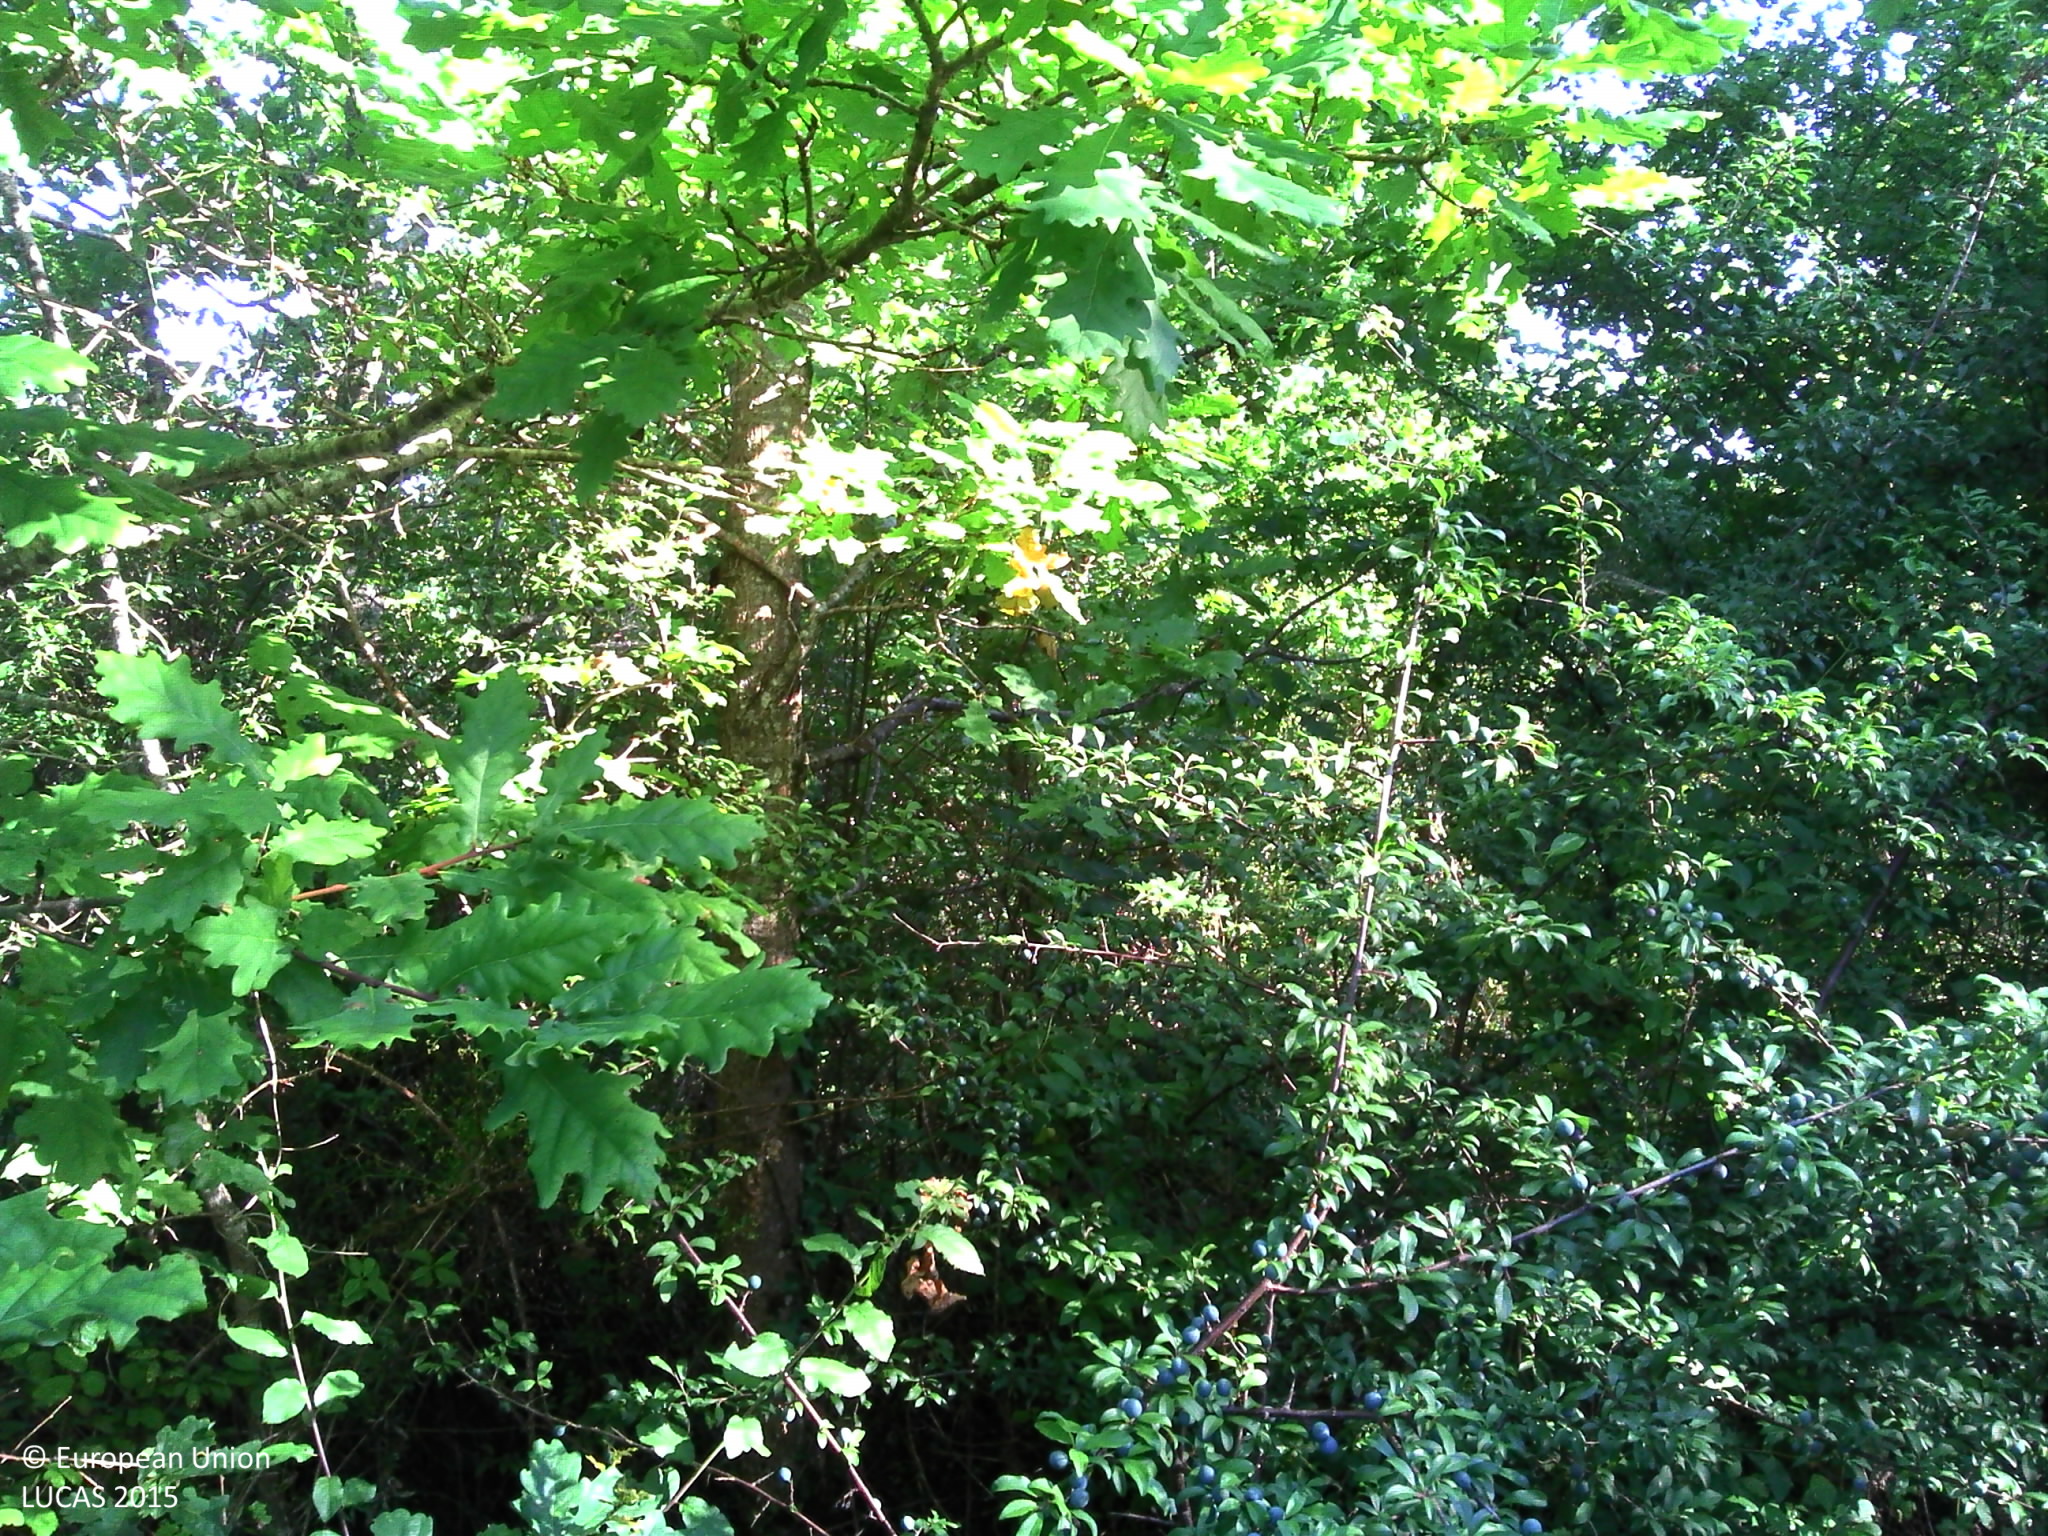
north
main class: Woodland
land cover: Broadleaved woodland
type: acidophilous oak and oak-birch forest
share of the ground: > 75 %
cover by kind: broadleaved forest trees 85 %, shrubs 10 %, herbaceous plants 5 %
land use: Semi-natural and natural areas not in use
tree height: > 5 m
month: June
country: FR
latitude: 45.8809
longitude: 0.3852
